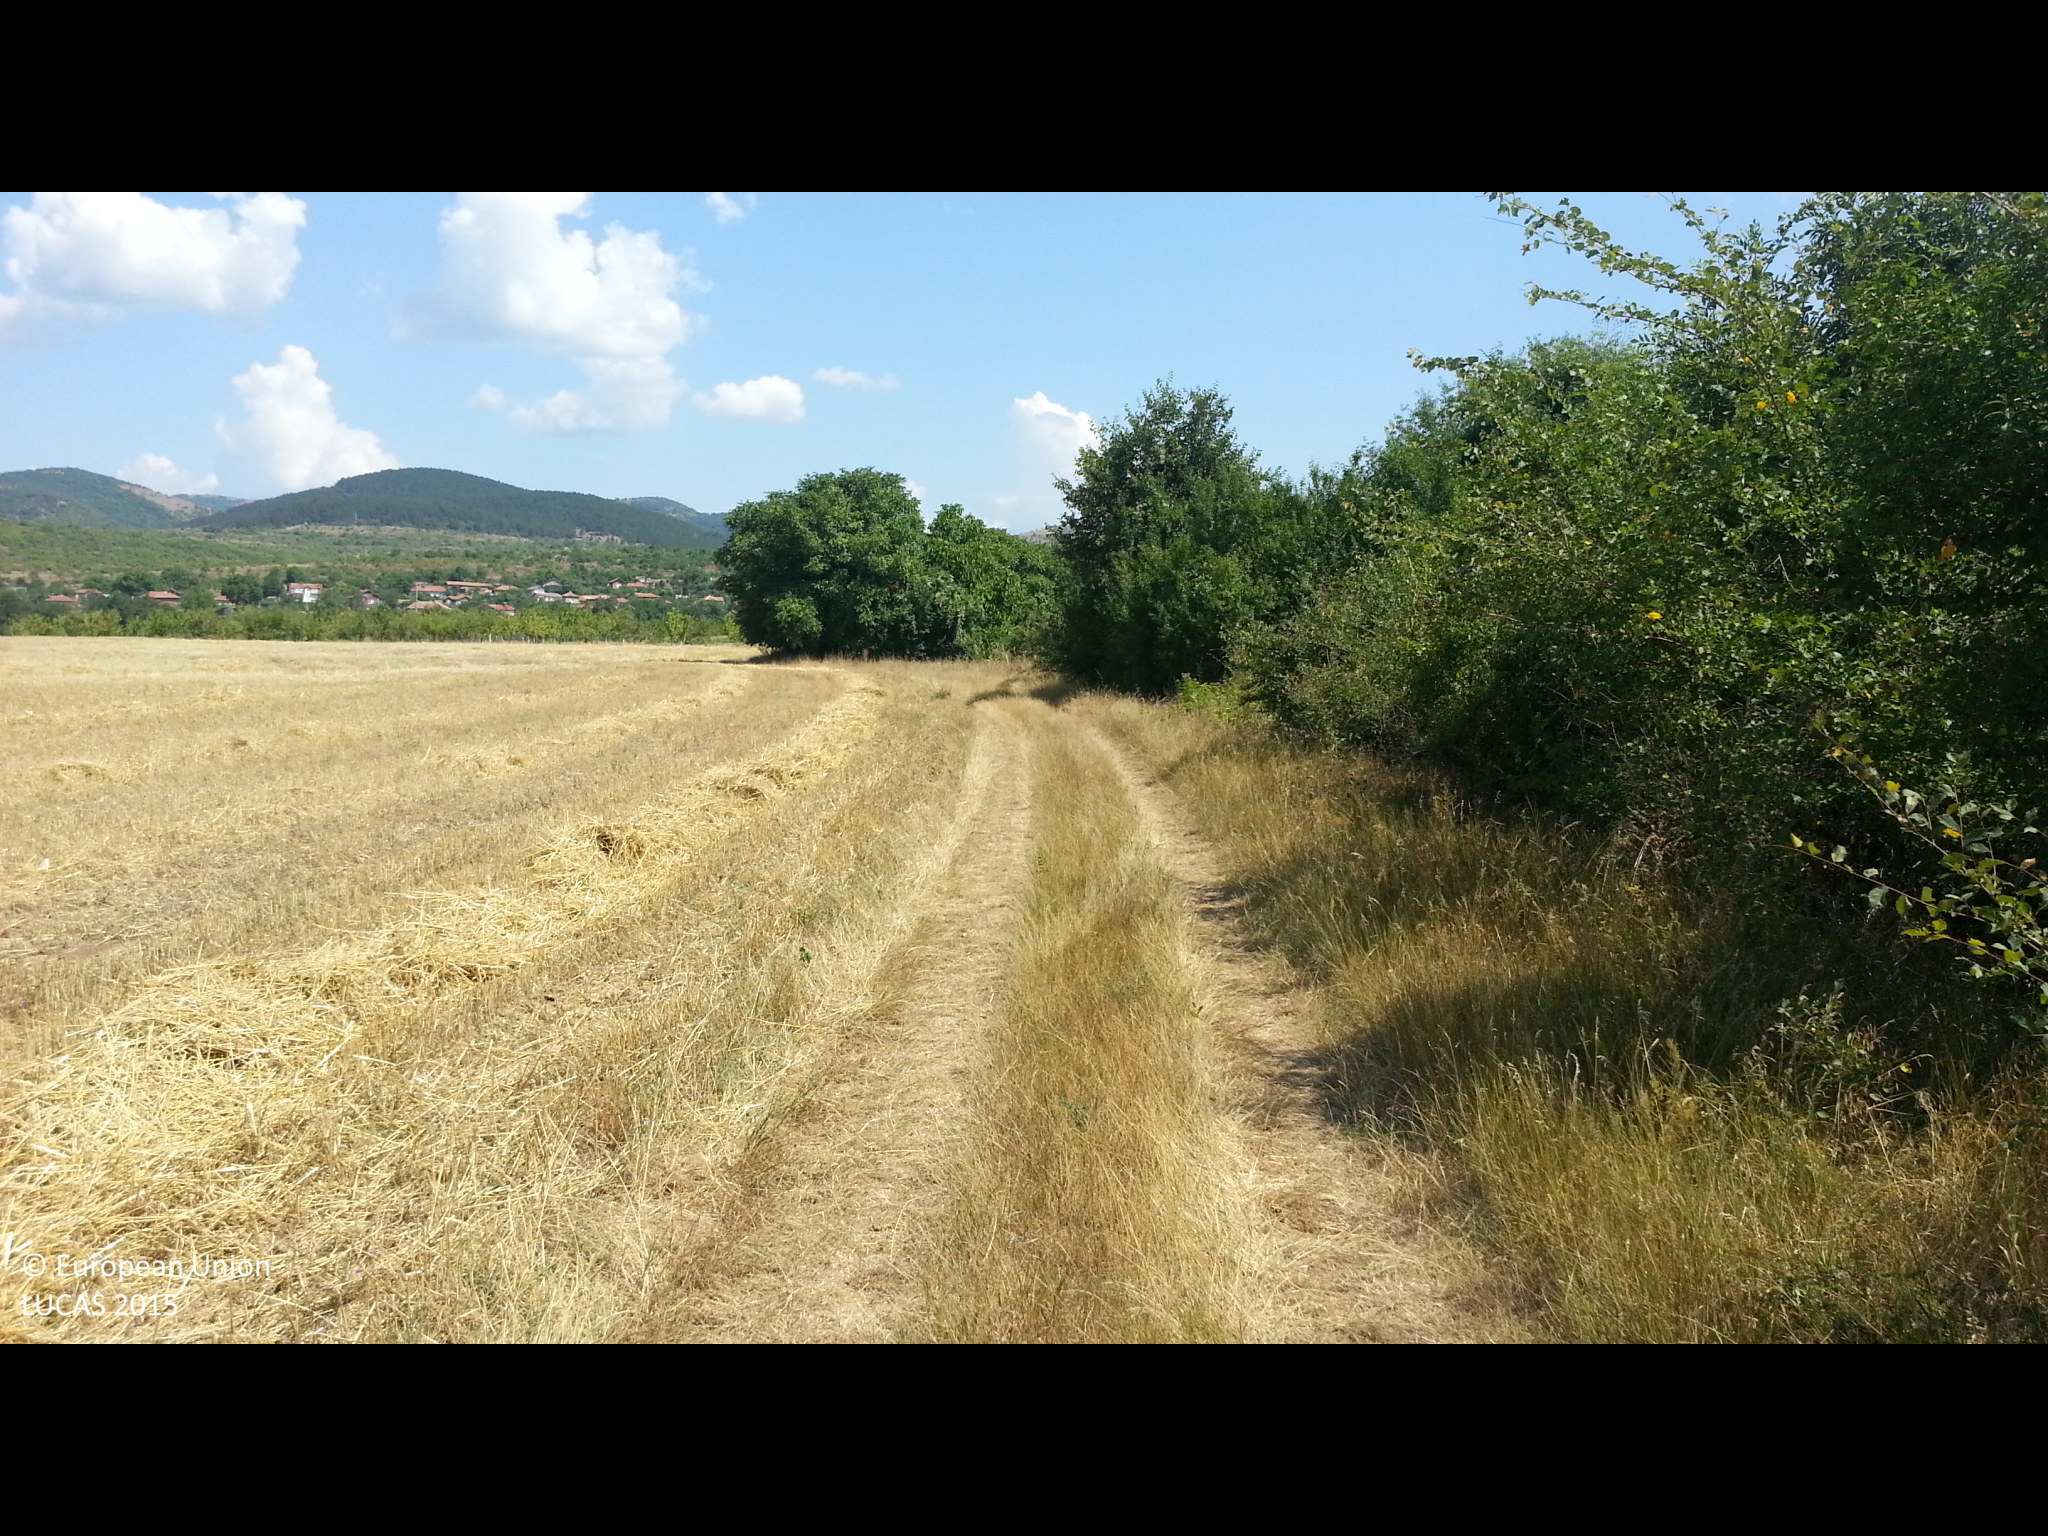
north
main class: Woodland
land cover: Broadleaved woodland
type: thermophilous deciduous forest
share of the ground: > 75 %
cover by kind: broadleaved forest trees 100 %
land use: Semi-natural and natural areas not in use
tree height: > 5 m
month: August
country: BG
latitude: 42.3162
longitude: 22.7749
